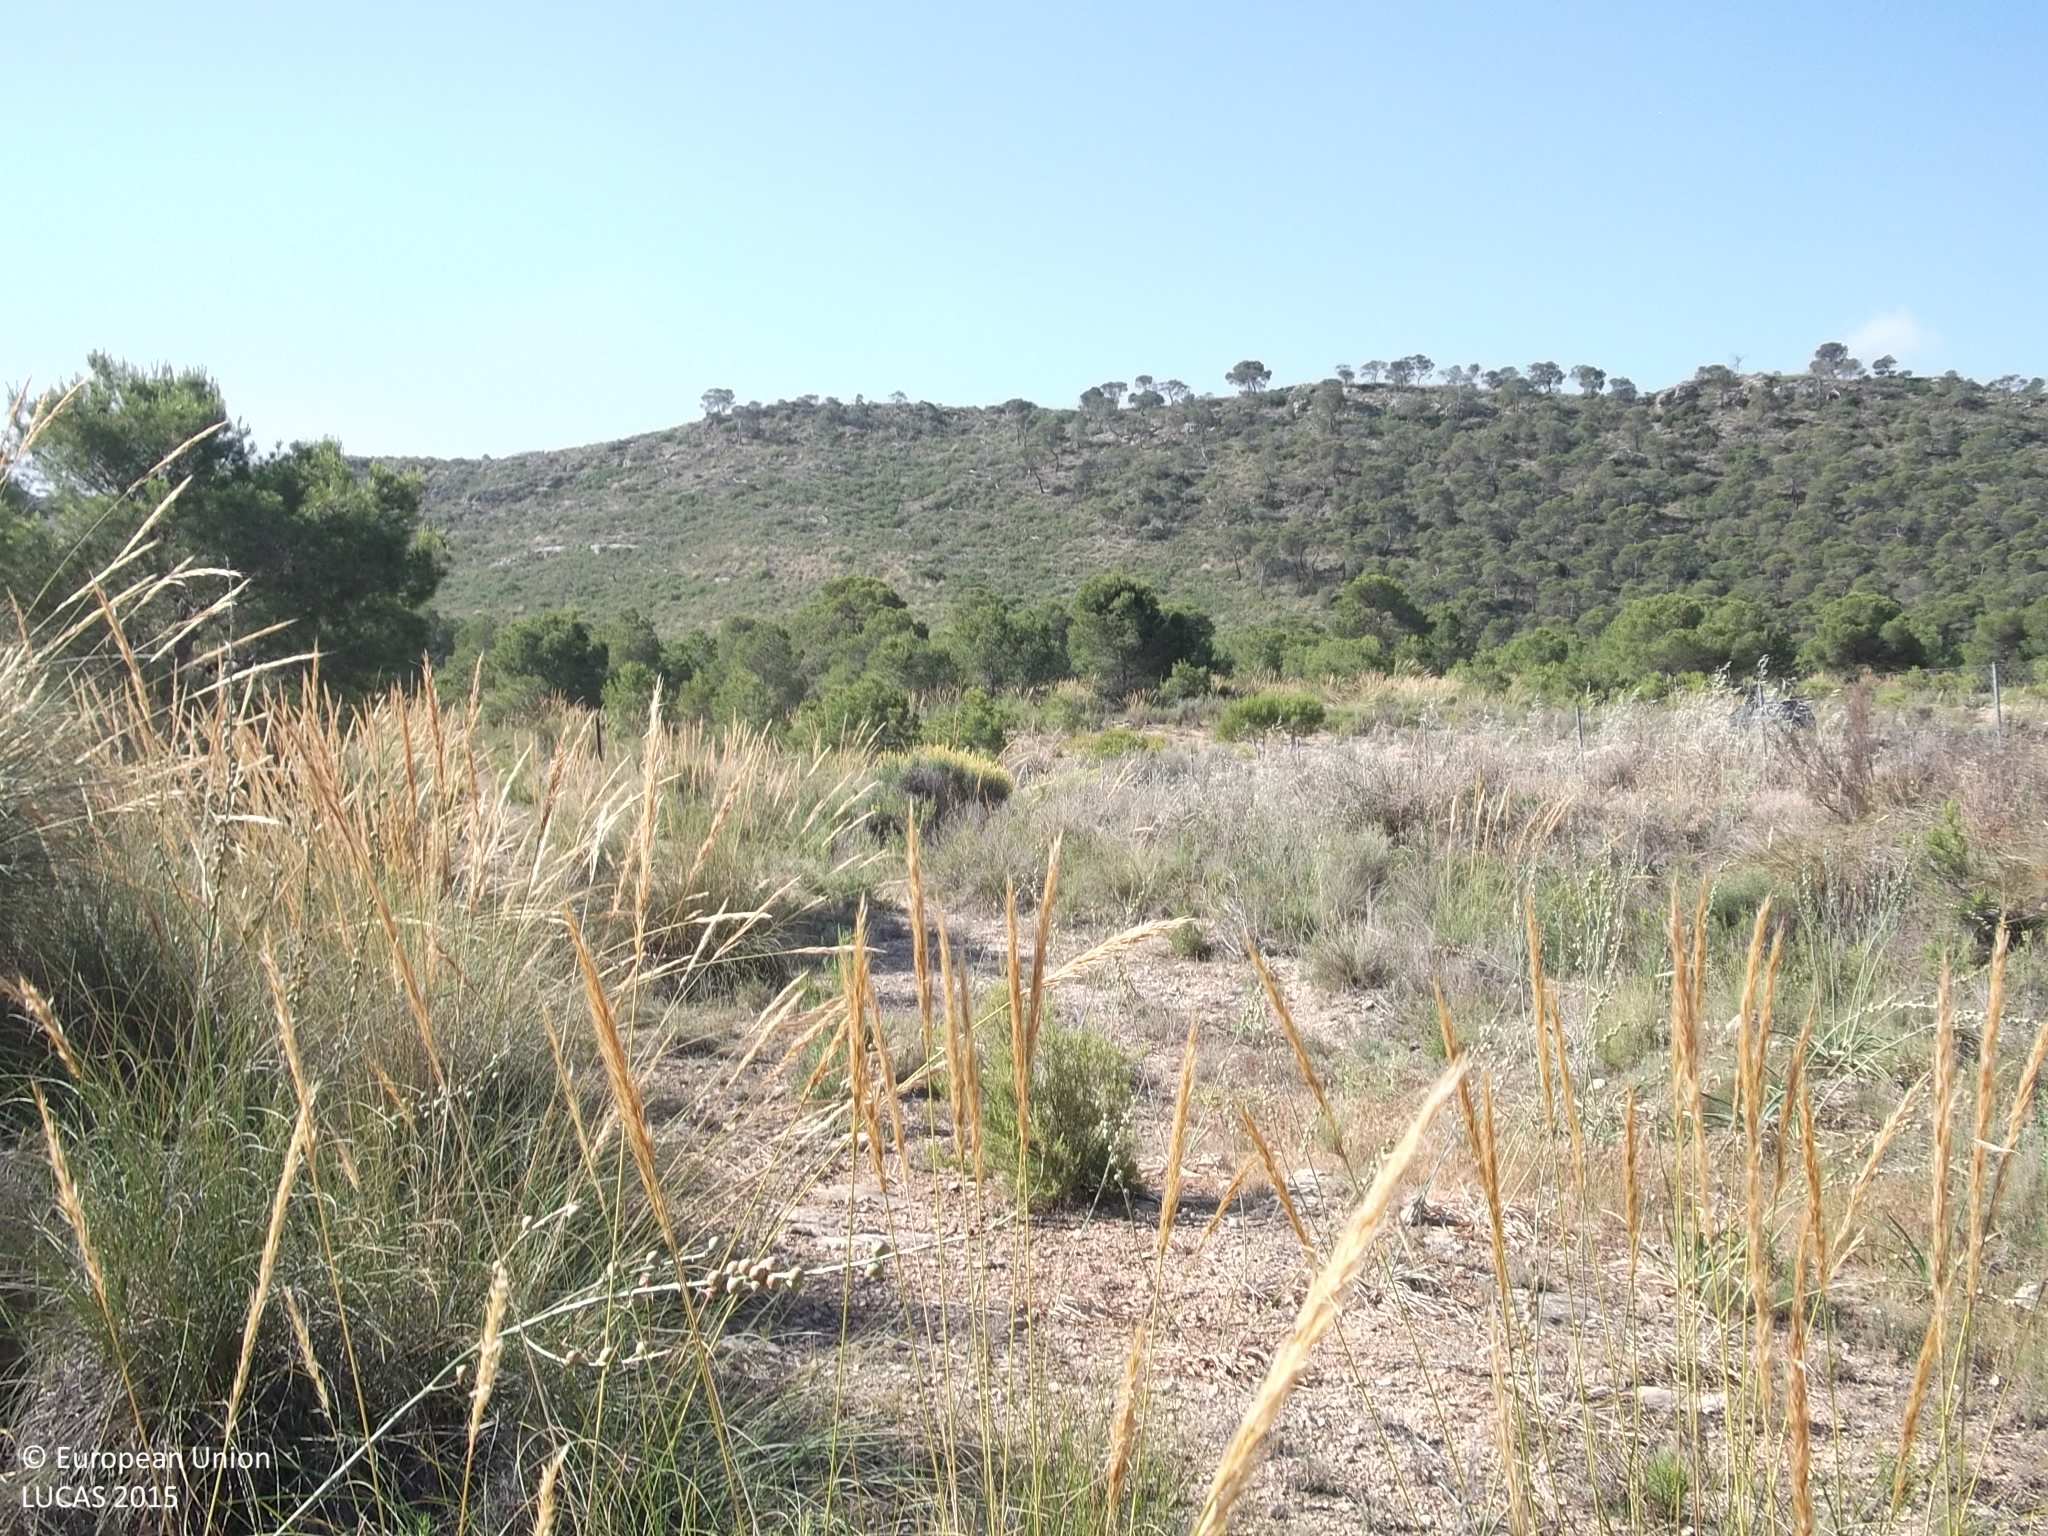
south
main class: Shrubland
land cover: Shrubland without tree cover
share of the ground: 50 - 75 %
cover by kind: shrubs 60 %, herbaceous plants 20 %, consolidated bare surface 20 %
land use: Semi-natural and natural areas not in use
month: May
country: ES
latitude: 38.4371
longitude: -1.5050
